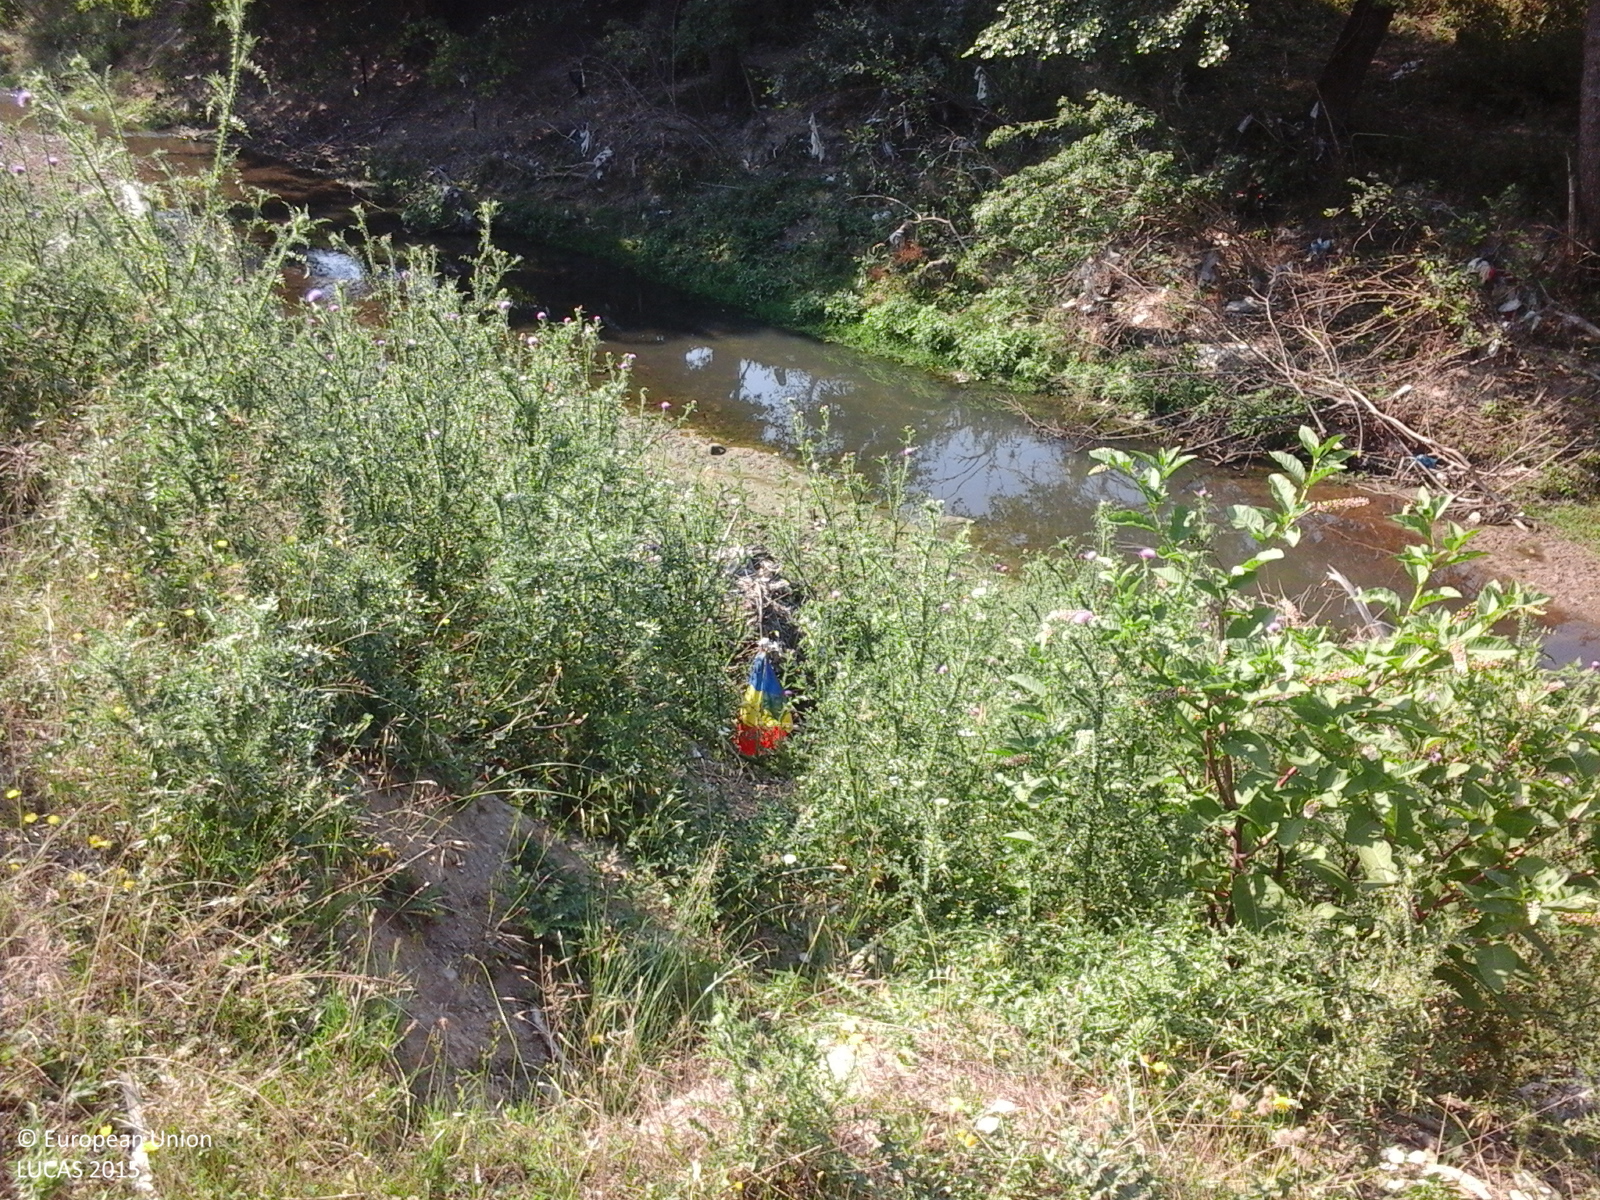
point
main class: Grassland
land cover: Spontaneously vegetated surfaces
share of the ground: > 75 %
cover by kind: herbaceous plants 100 %
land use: Semi-natural and natural areas not in use
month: July
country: RO
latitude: 44.8891
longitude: 24.8317
